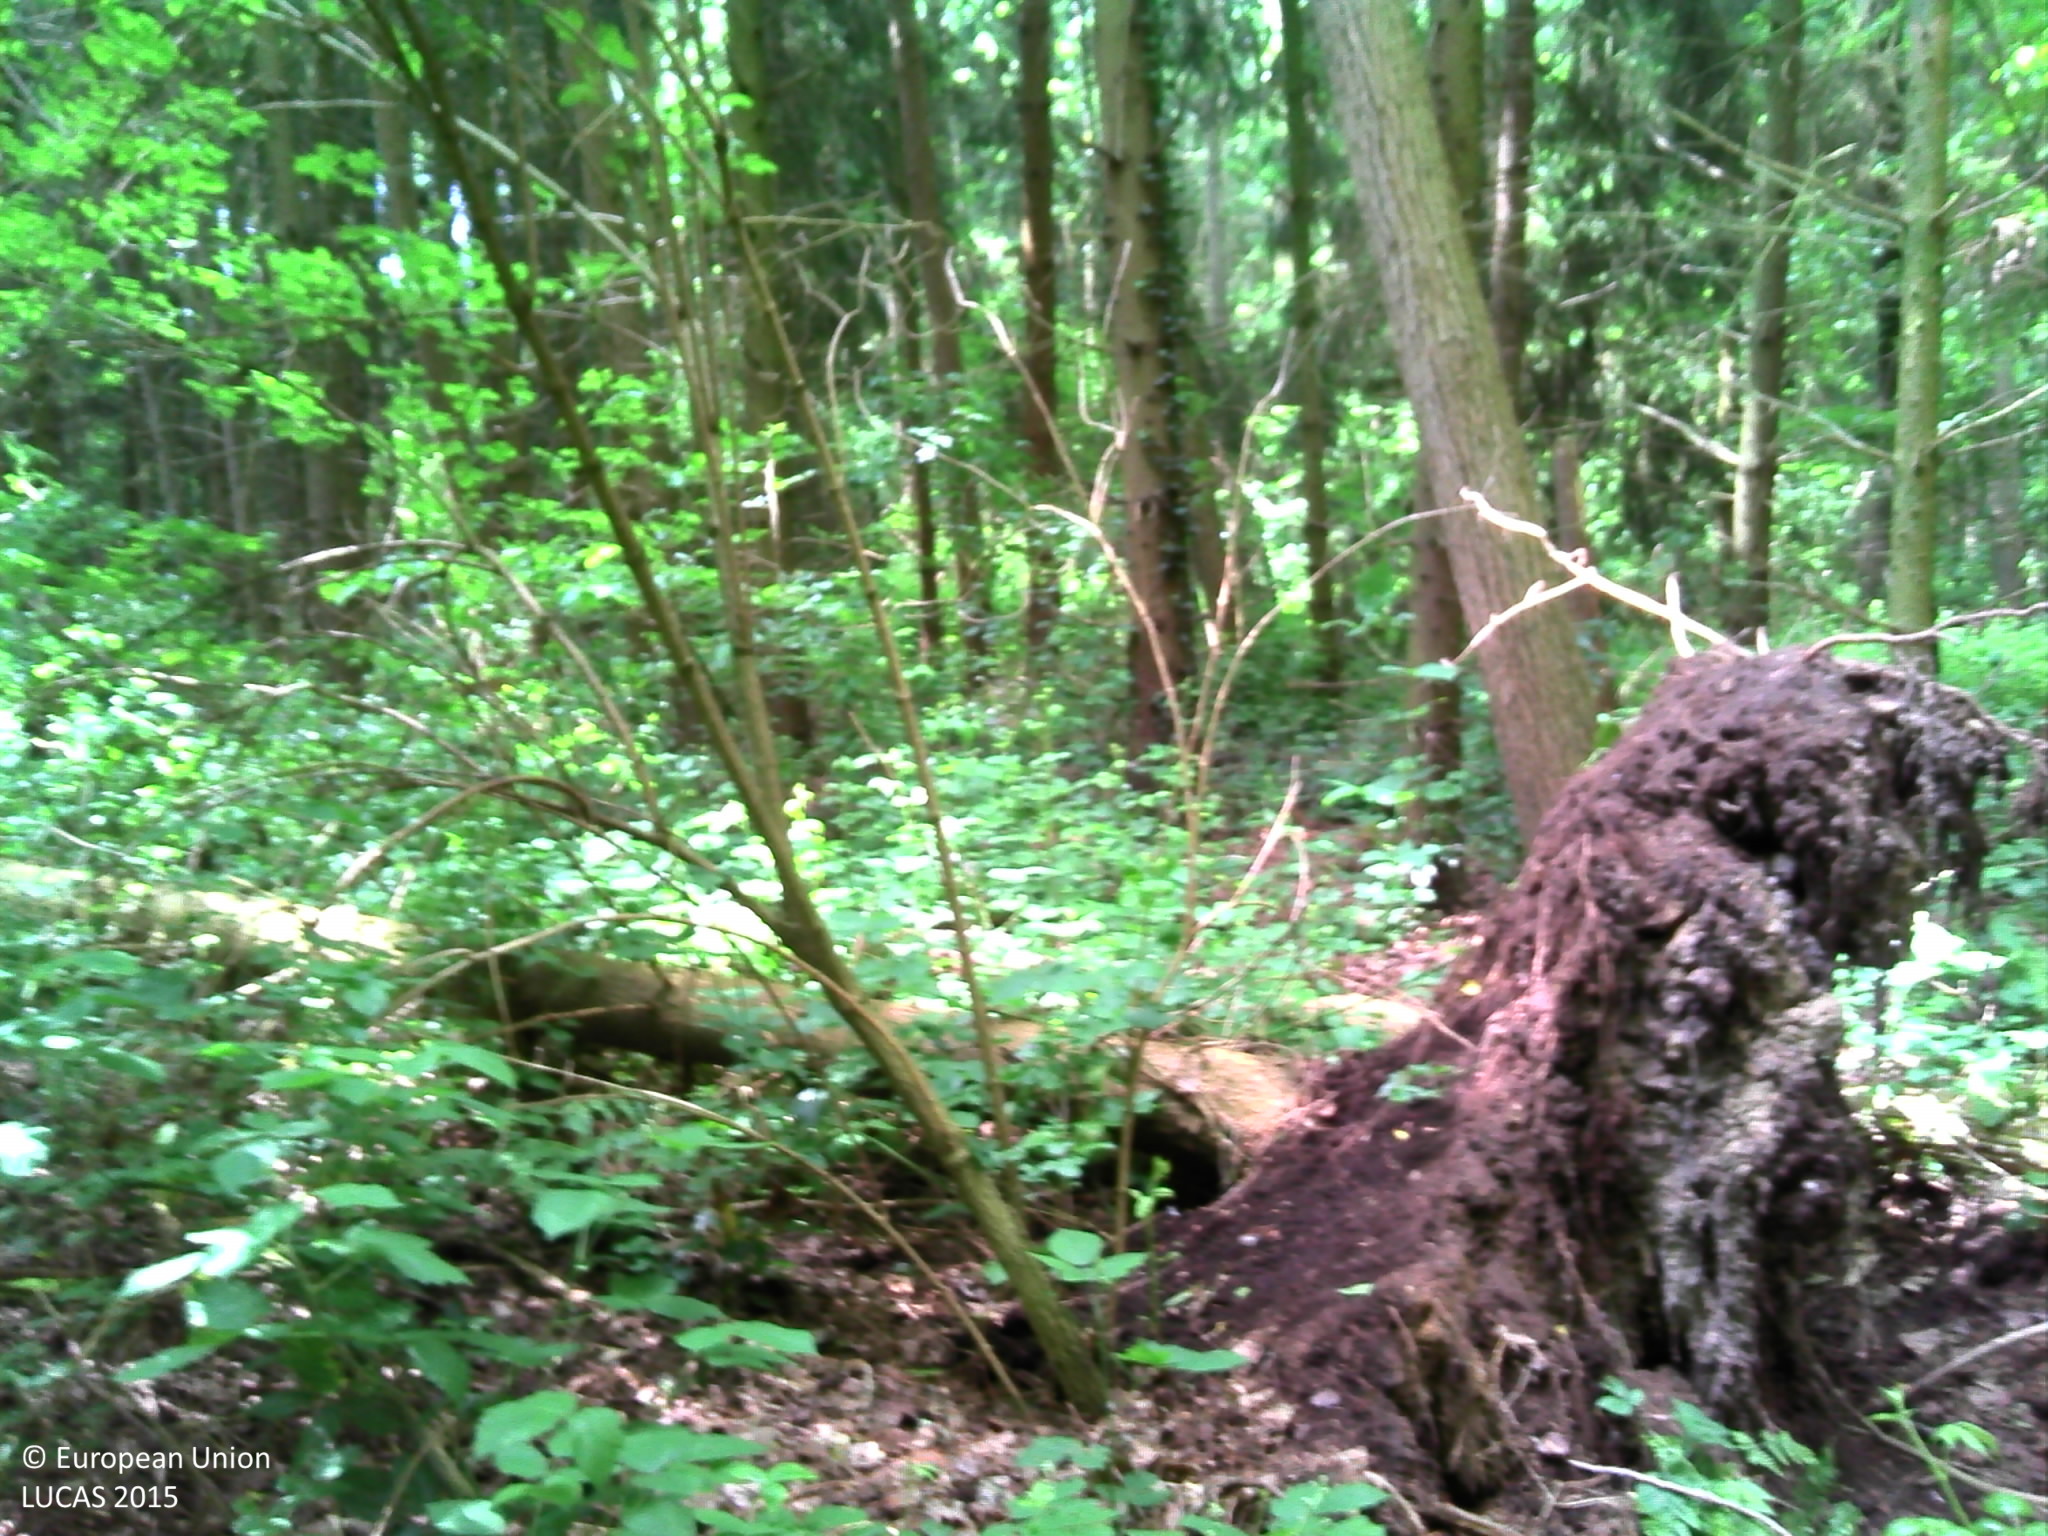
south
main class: Woodland
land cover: Spruce dominated coniferous woodland
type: hemiboreal forest and nemoral coniferous forest and mixed broadleaved-coniferous forest
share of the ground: > 75 %
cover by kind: coniferous forest trees 100 %
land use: Forestry
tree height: > 5 m
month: June
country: BE
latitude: 50.9400
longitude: 3.8885
